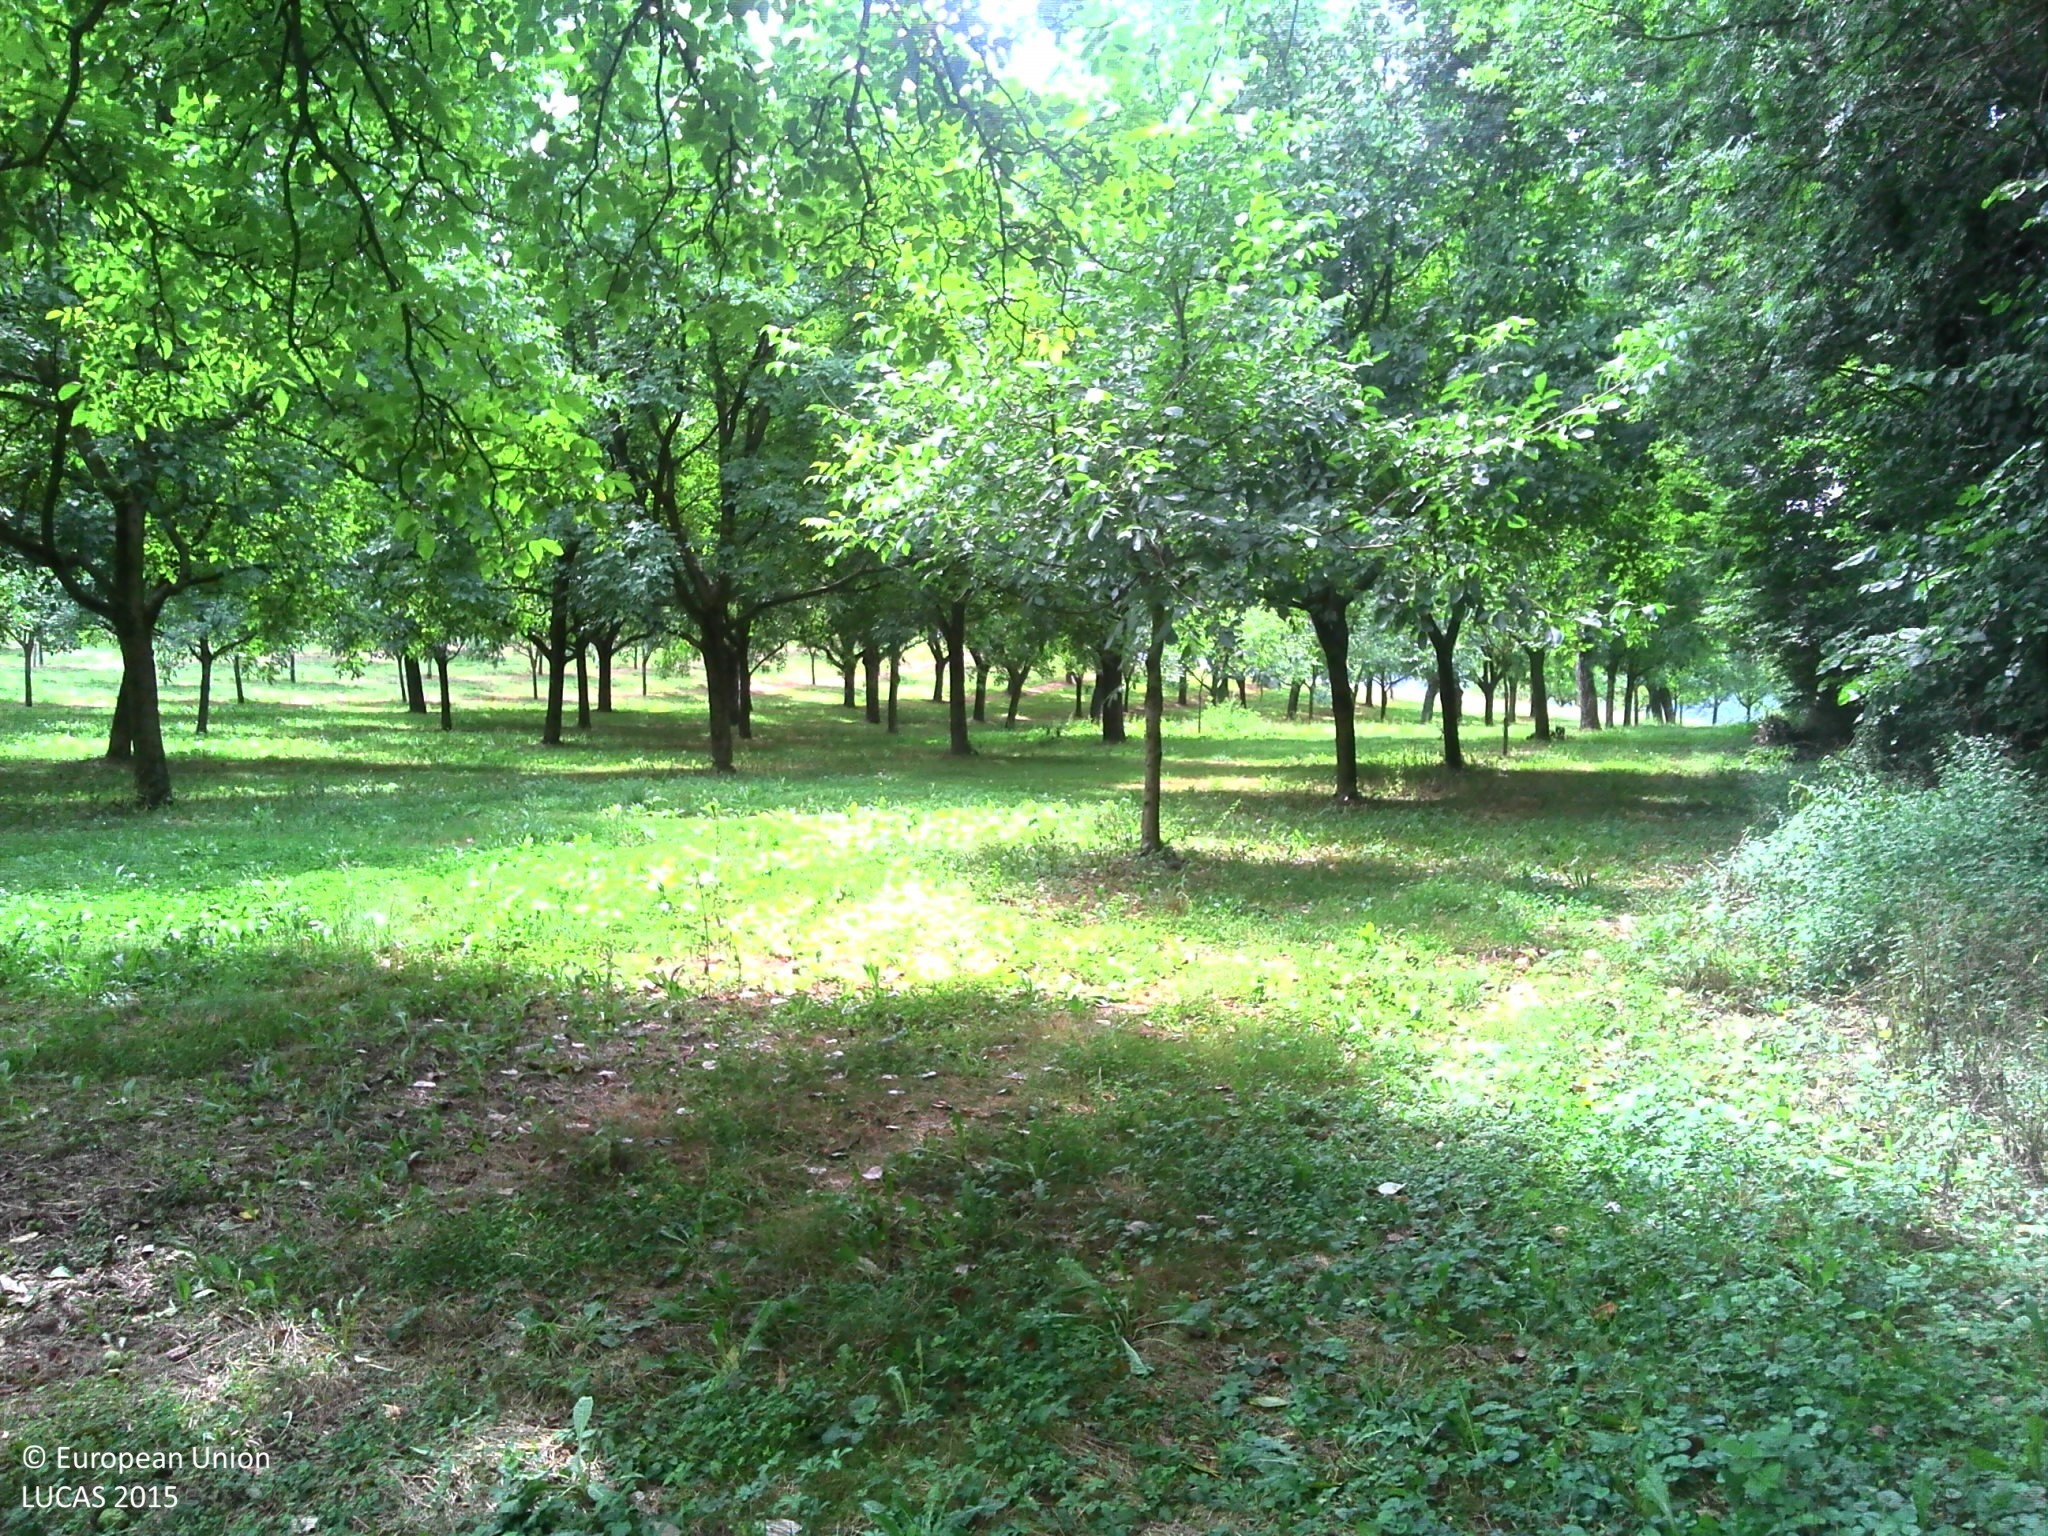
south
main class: Grassland
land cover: Grassland without tree/shrub cover
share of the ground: > 75 %
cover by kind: herbaceous plants 100 %
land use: Agriculture (excluding fallow land and kitchen gardens)
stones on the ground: < 10 %
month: August
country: FR
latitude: 45.2442
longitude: 5.4570
